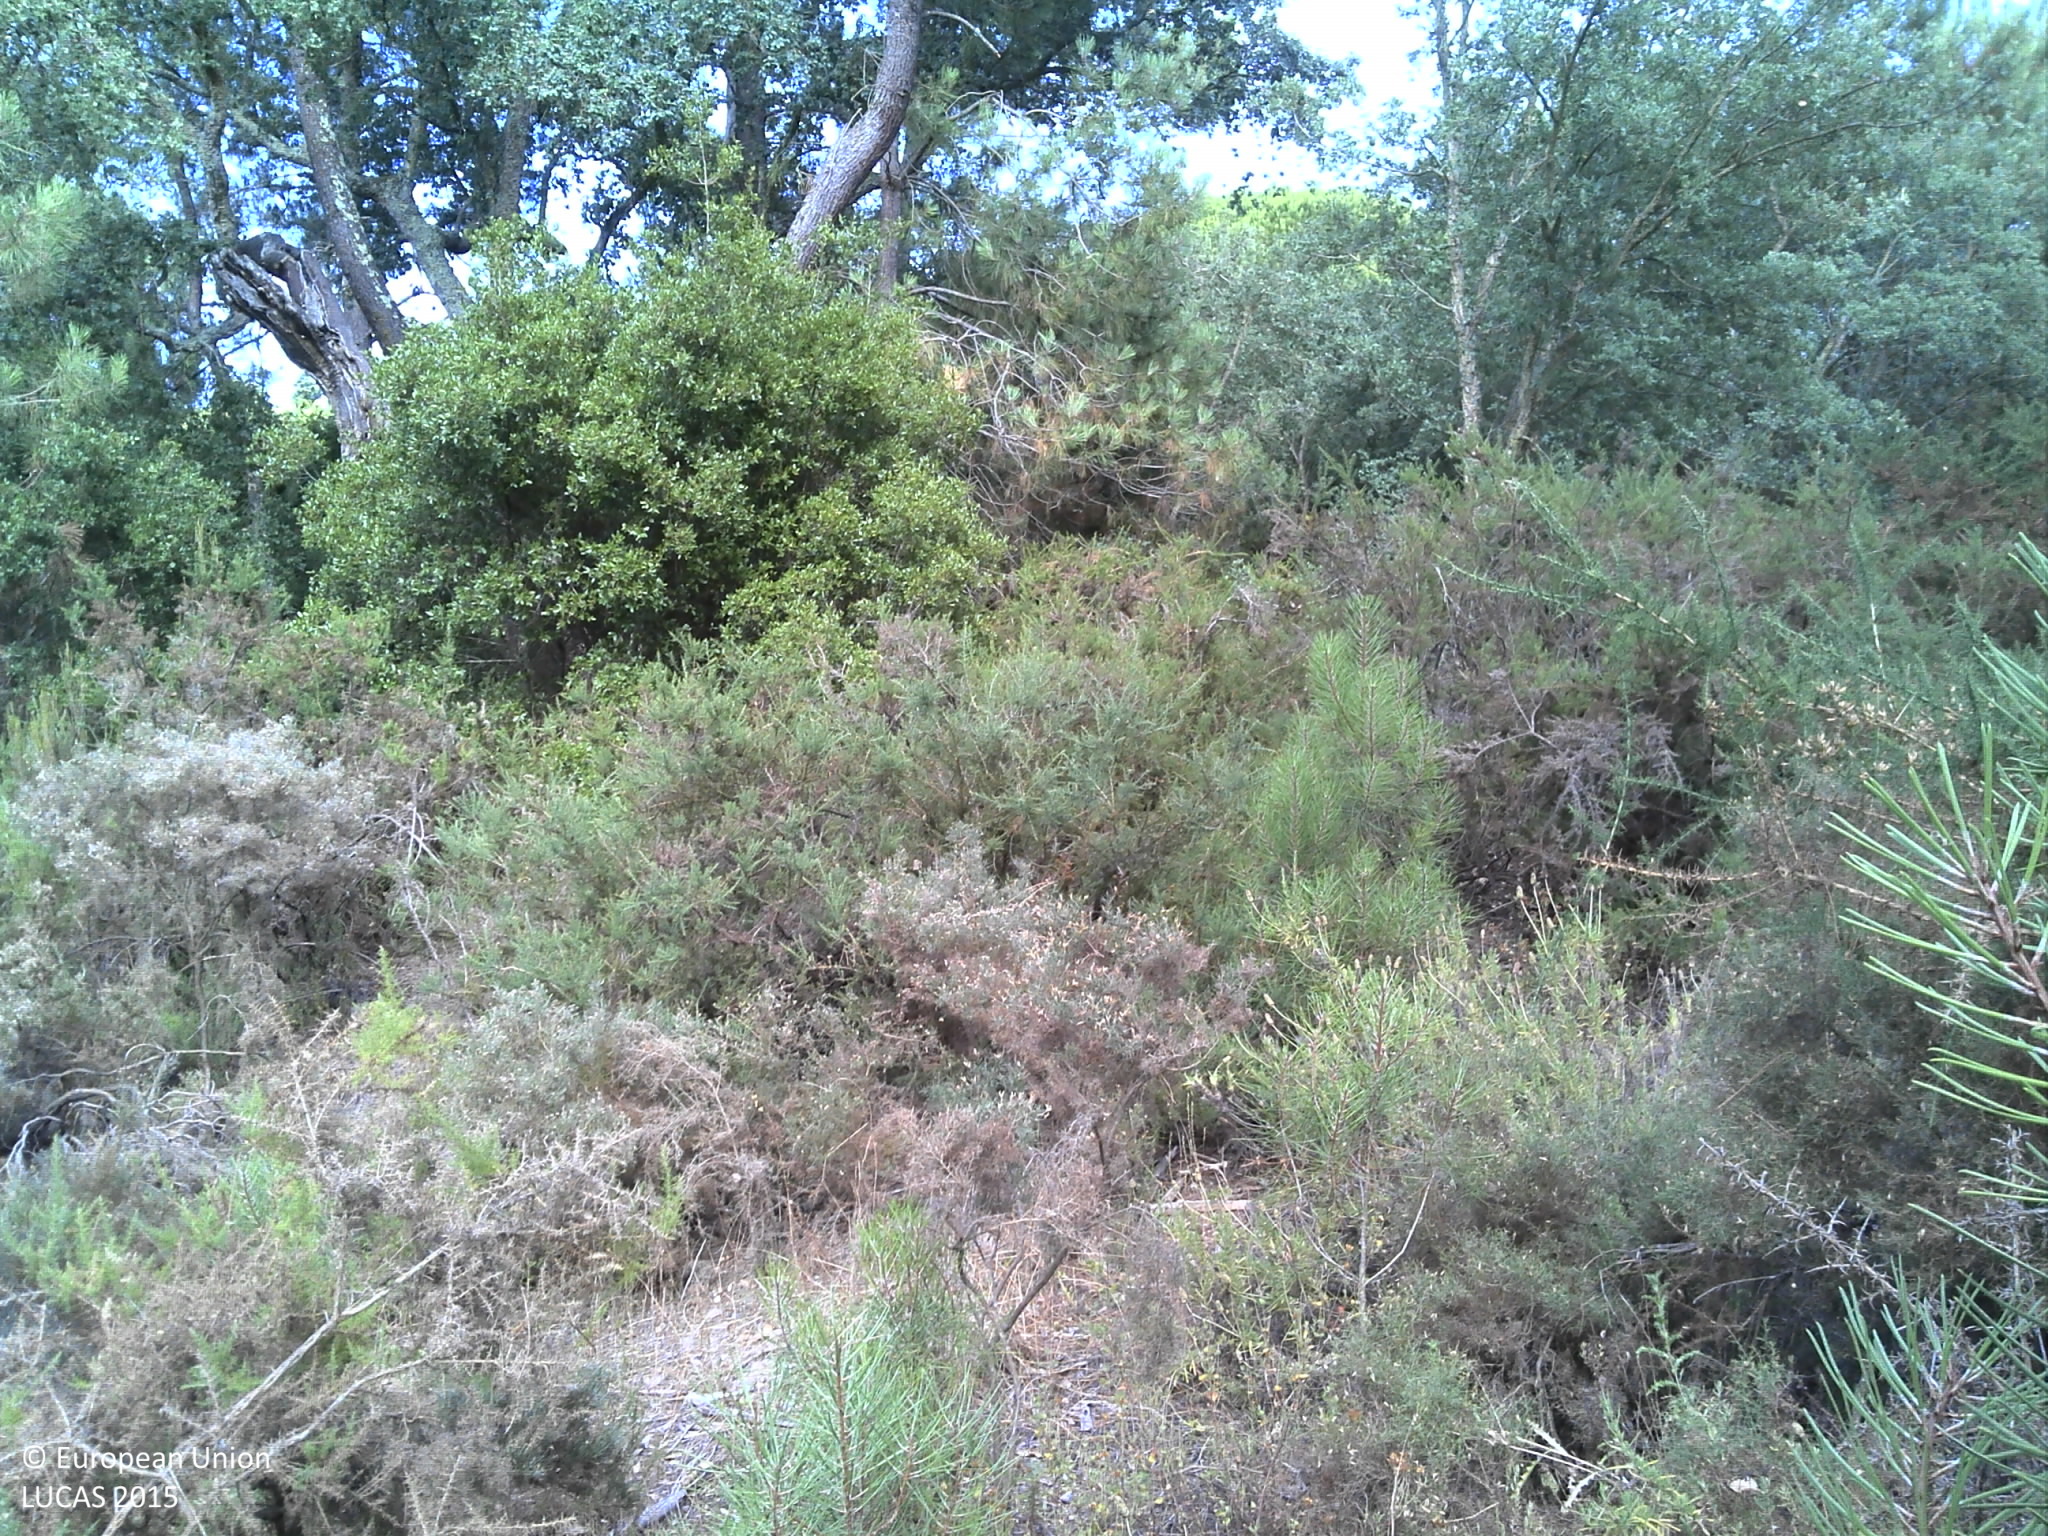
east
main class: Woodland
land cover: Pine dominated mixed woodland
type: coniferous forest of the mediterranean region
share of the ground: 50 - 75 %
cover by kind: coniferous forest trees 35 %, broadleaved forest trees 30 %, shrubs 20 %, unconsolidated bare surface 15 %
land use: Forestry
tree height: > 5 m
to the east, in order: Pine dominated mixed woodland; Shrubland with sparse tree cover; Grassland with sparse tree/shrub cover; Grassland without tree/shrub cover; Tracks; Grassland without tree/shrub cover; Pine dominated coniferous woodland; Grassland with sparse tree/shrub cover
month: June
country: PT
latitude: 38.4802
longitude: -9.1098
